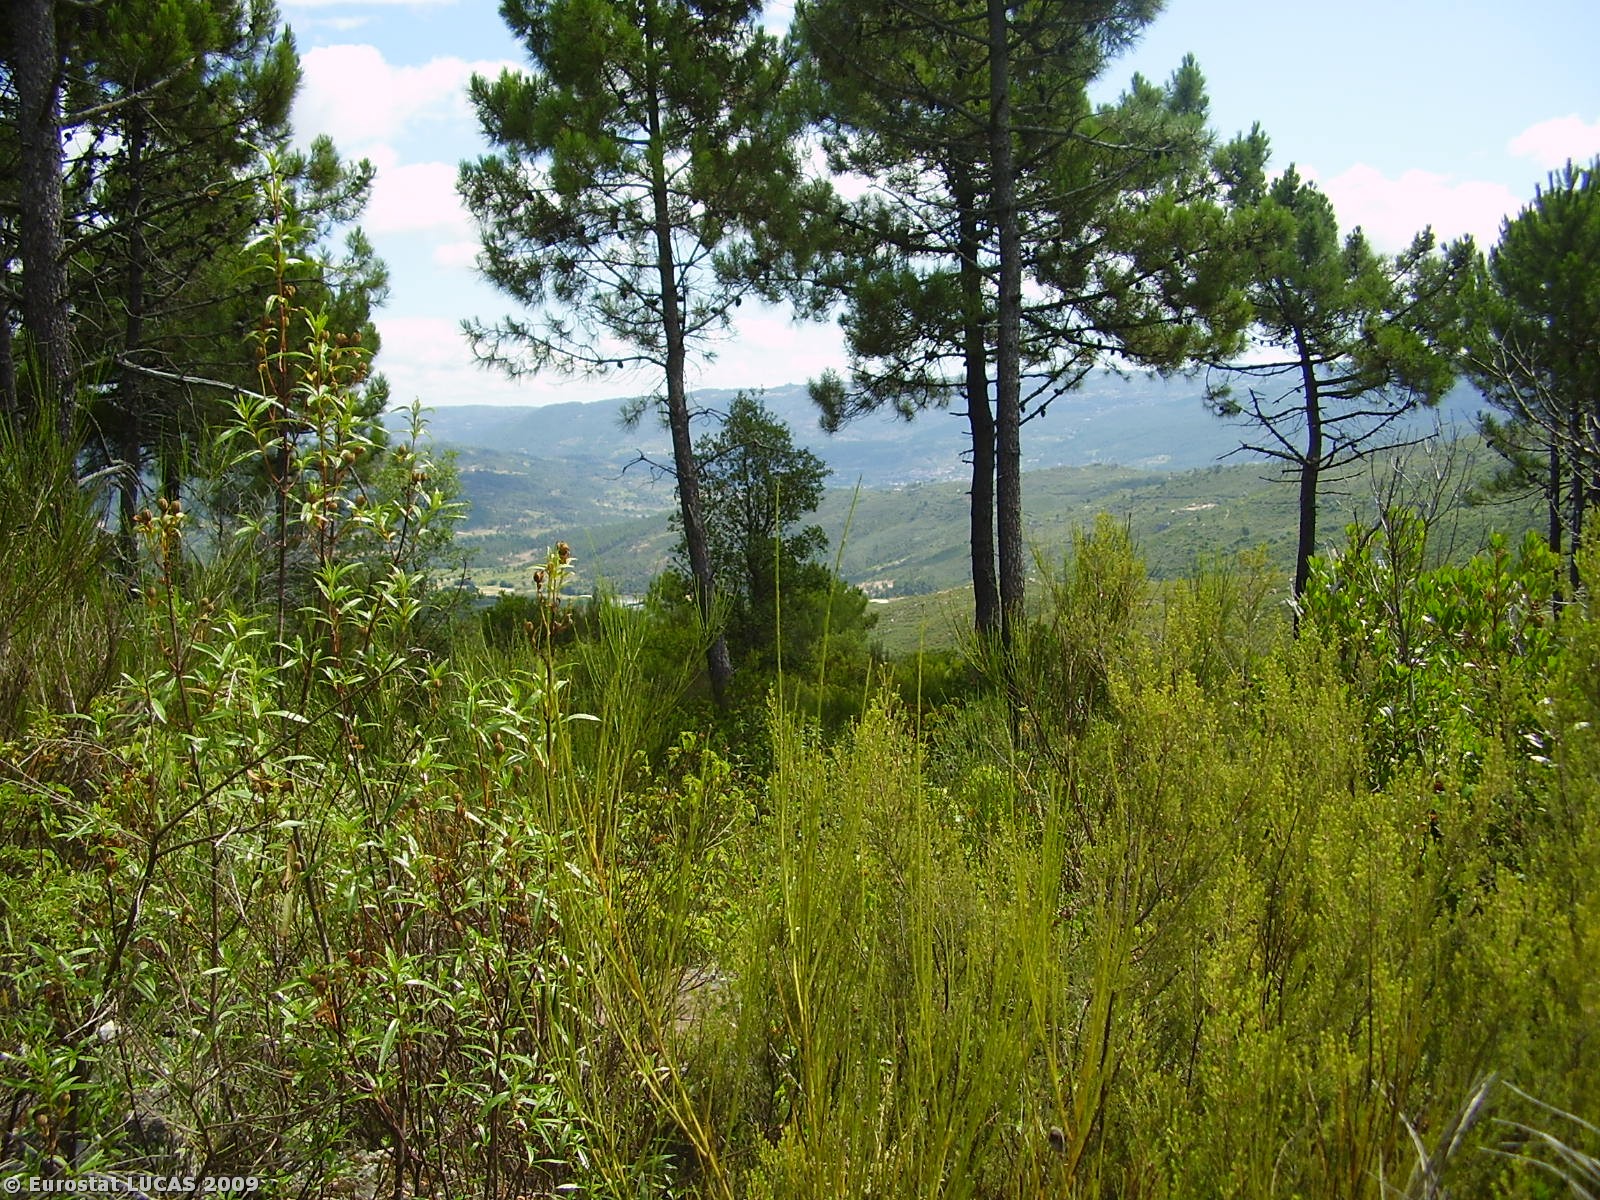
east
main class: Shrubland
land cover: Shrubland with sparse tree cover
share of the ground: > 75 %
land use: Unused
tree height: > 5 m
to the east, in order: Shrubland with sparse tree cover; Rock outcrops; Coniferous woodland; Shrubland with sparse tree cover; Bare land
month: July
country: PT
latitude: 41.5986
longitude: -7.5877
